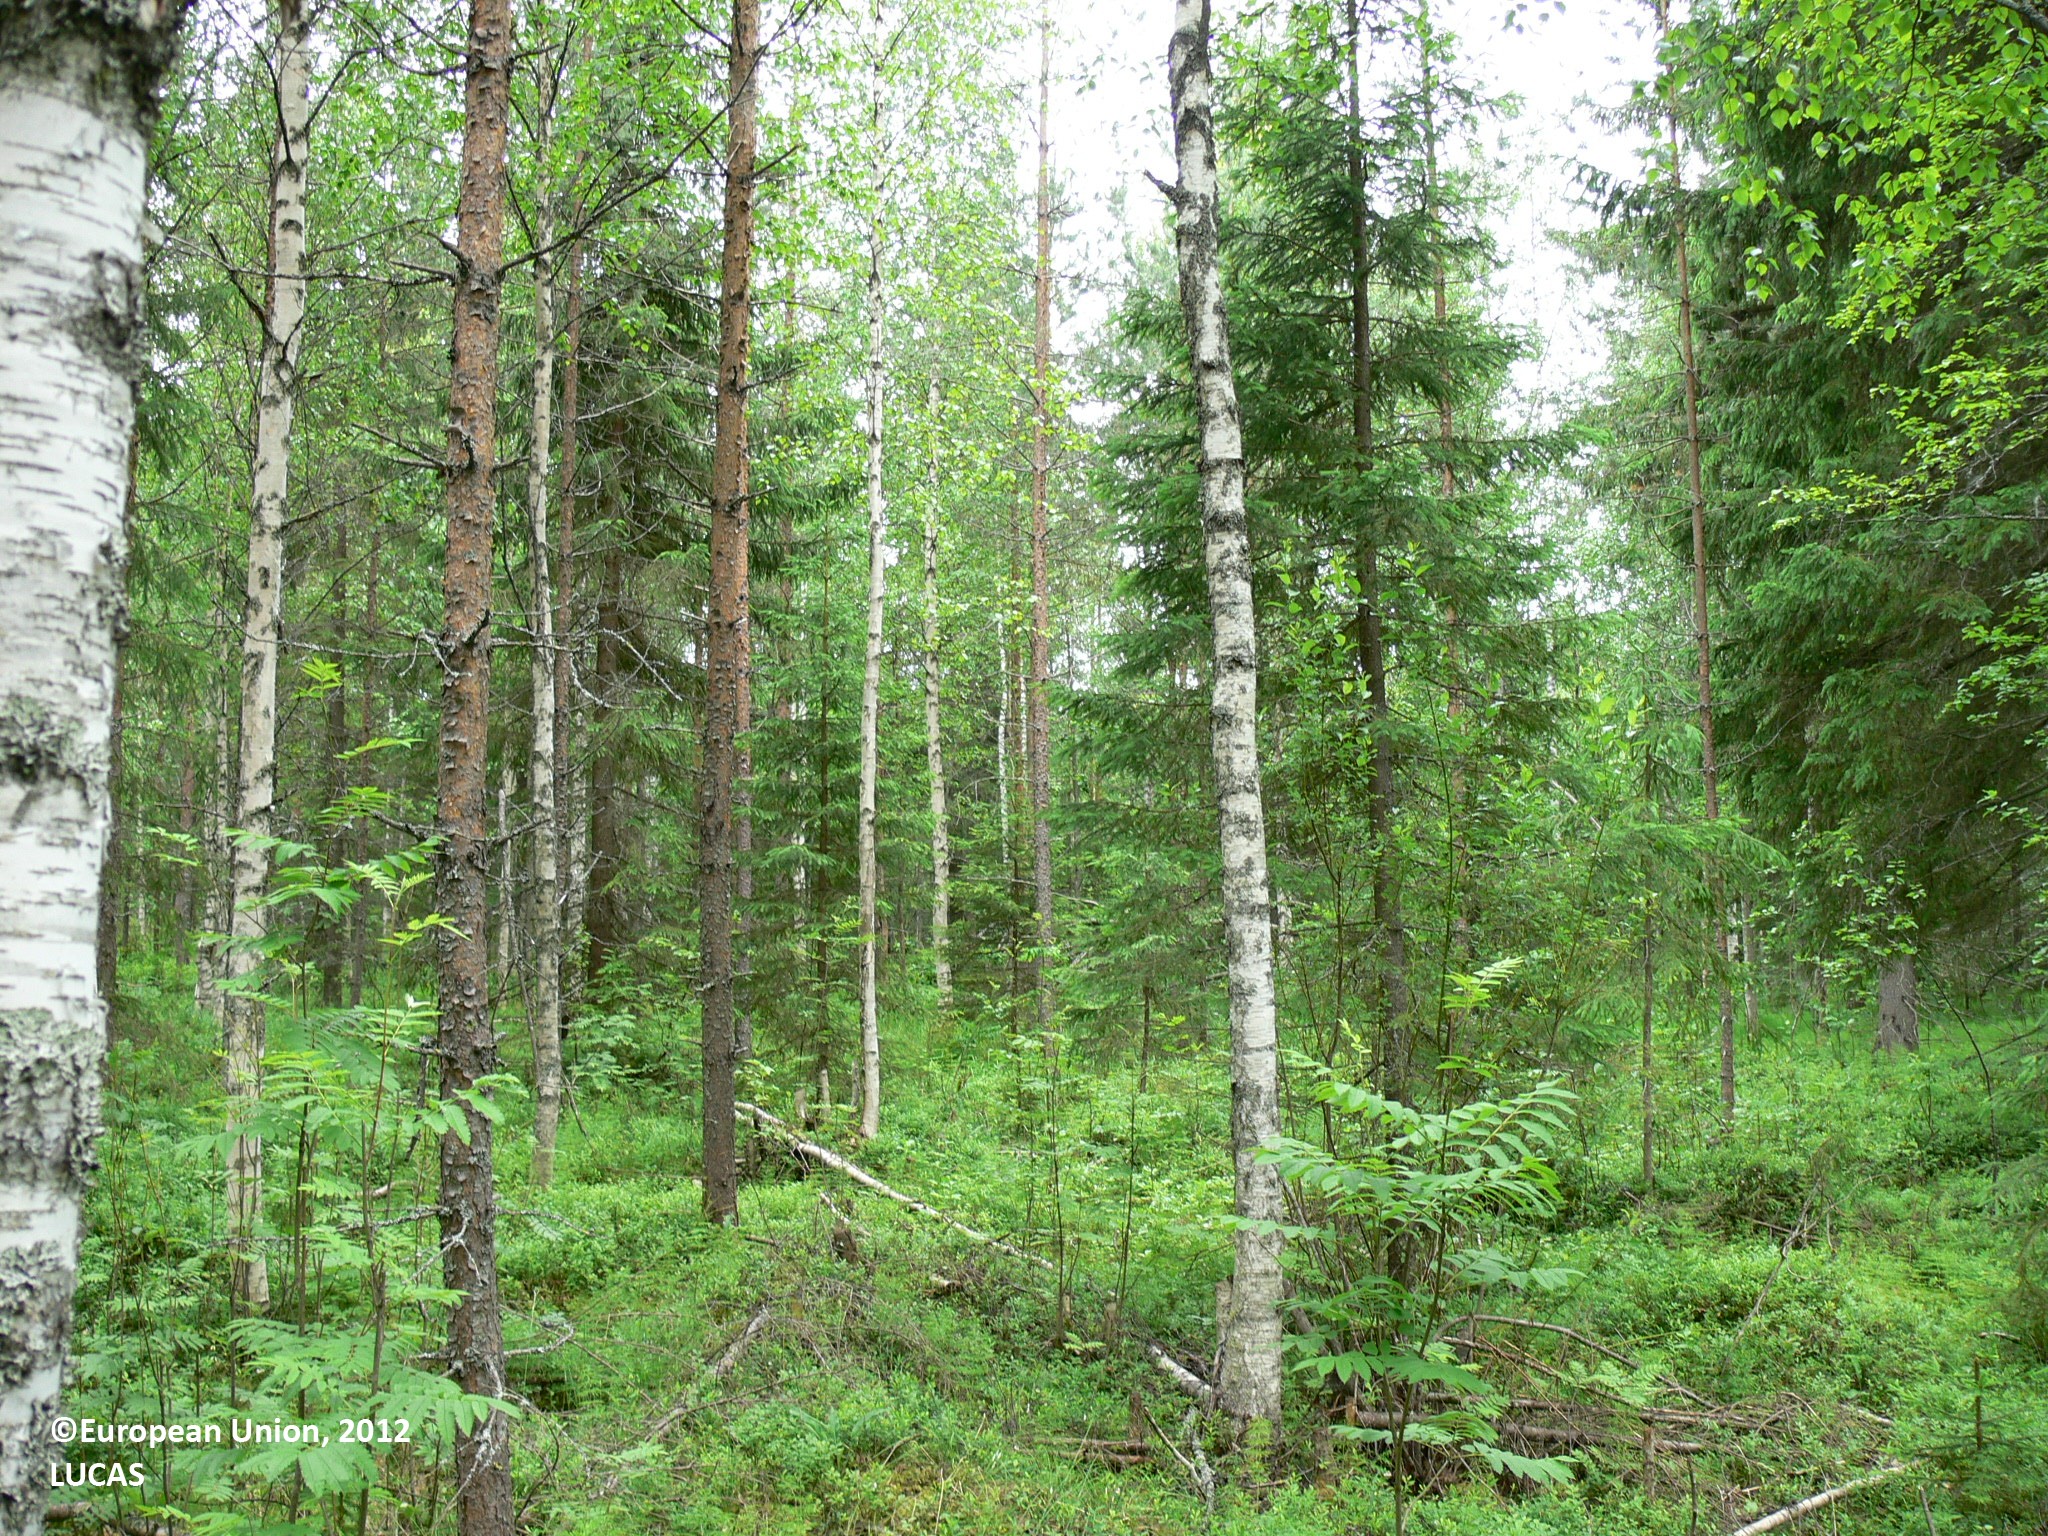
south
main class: Woodland
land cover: Other mixed woodland
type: boreal forest
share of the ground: > 75 %
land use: Forestry
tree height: > 5 m
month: June
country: FI
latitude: 62.8462
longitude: 29.3800
